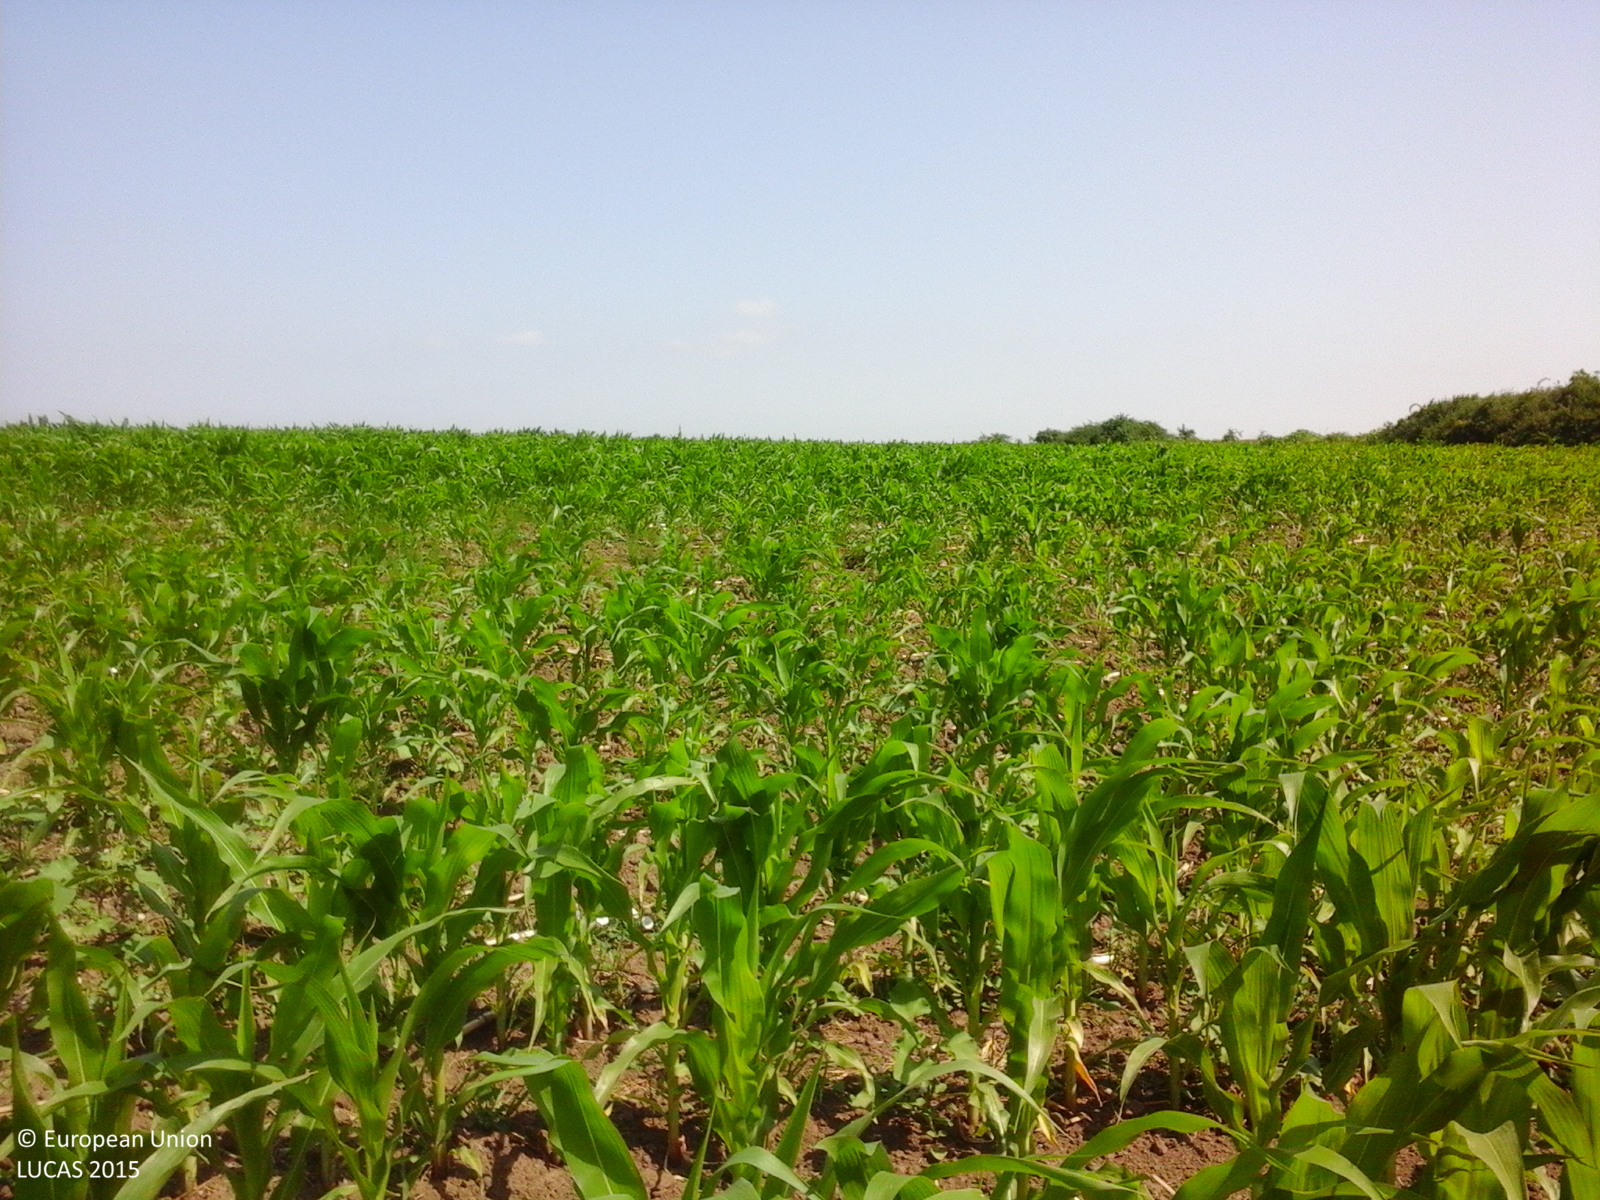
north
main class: Cropland
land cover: Maize
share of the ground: 50 - 75 %
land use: Agriculture (excluding fallow land and kitchen gardens)
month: June
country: RO
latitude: 46.7787
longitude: 27.0067
